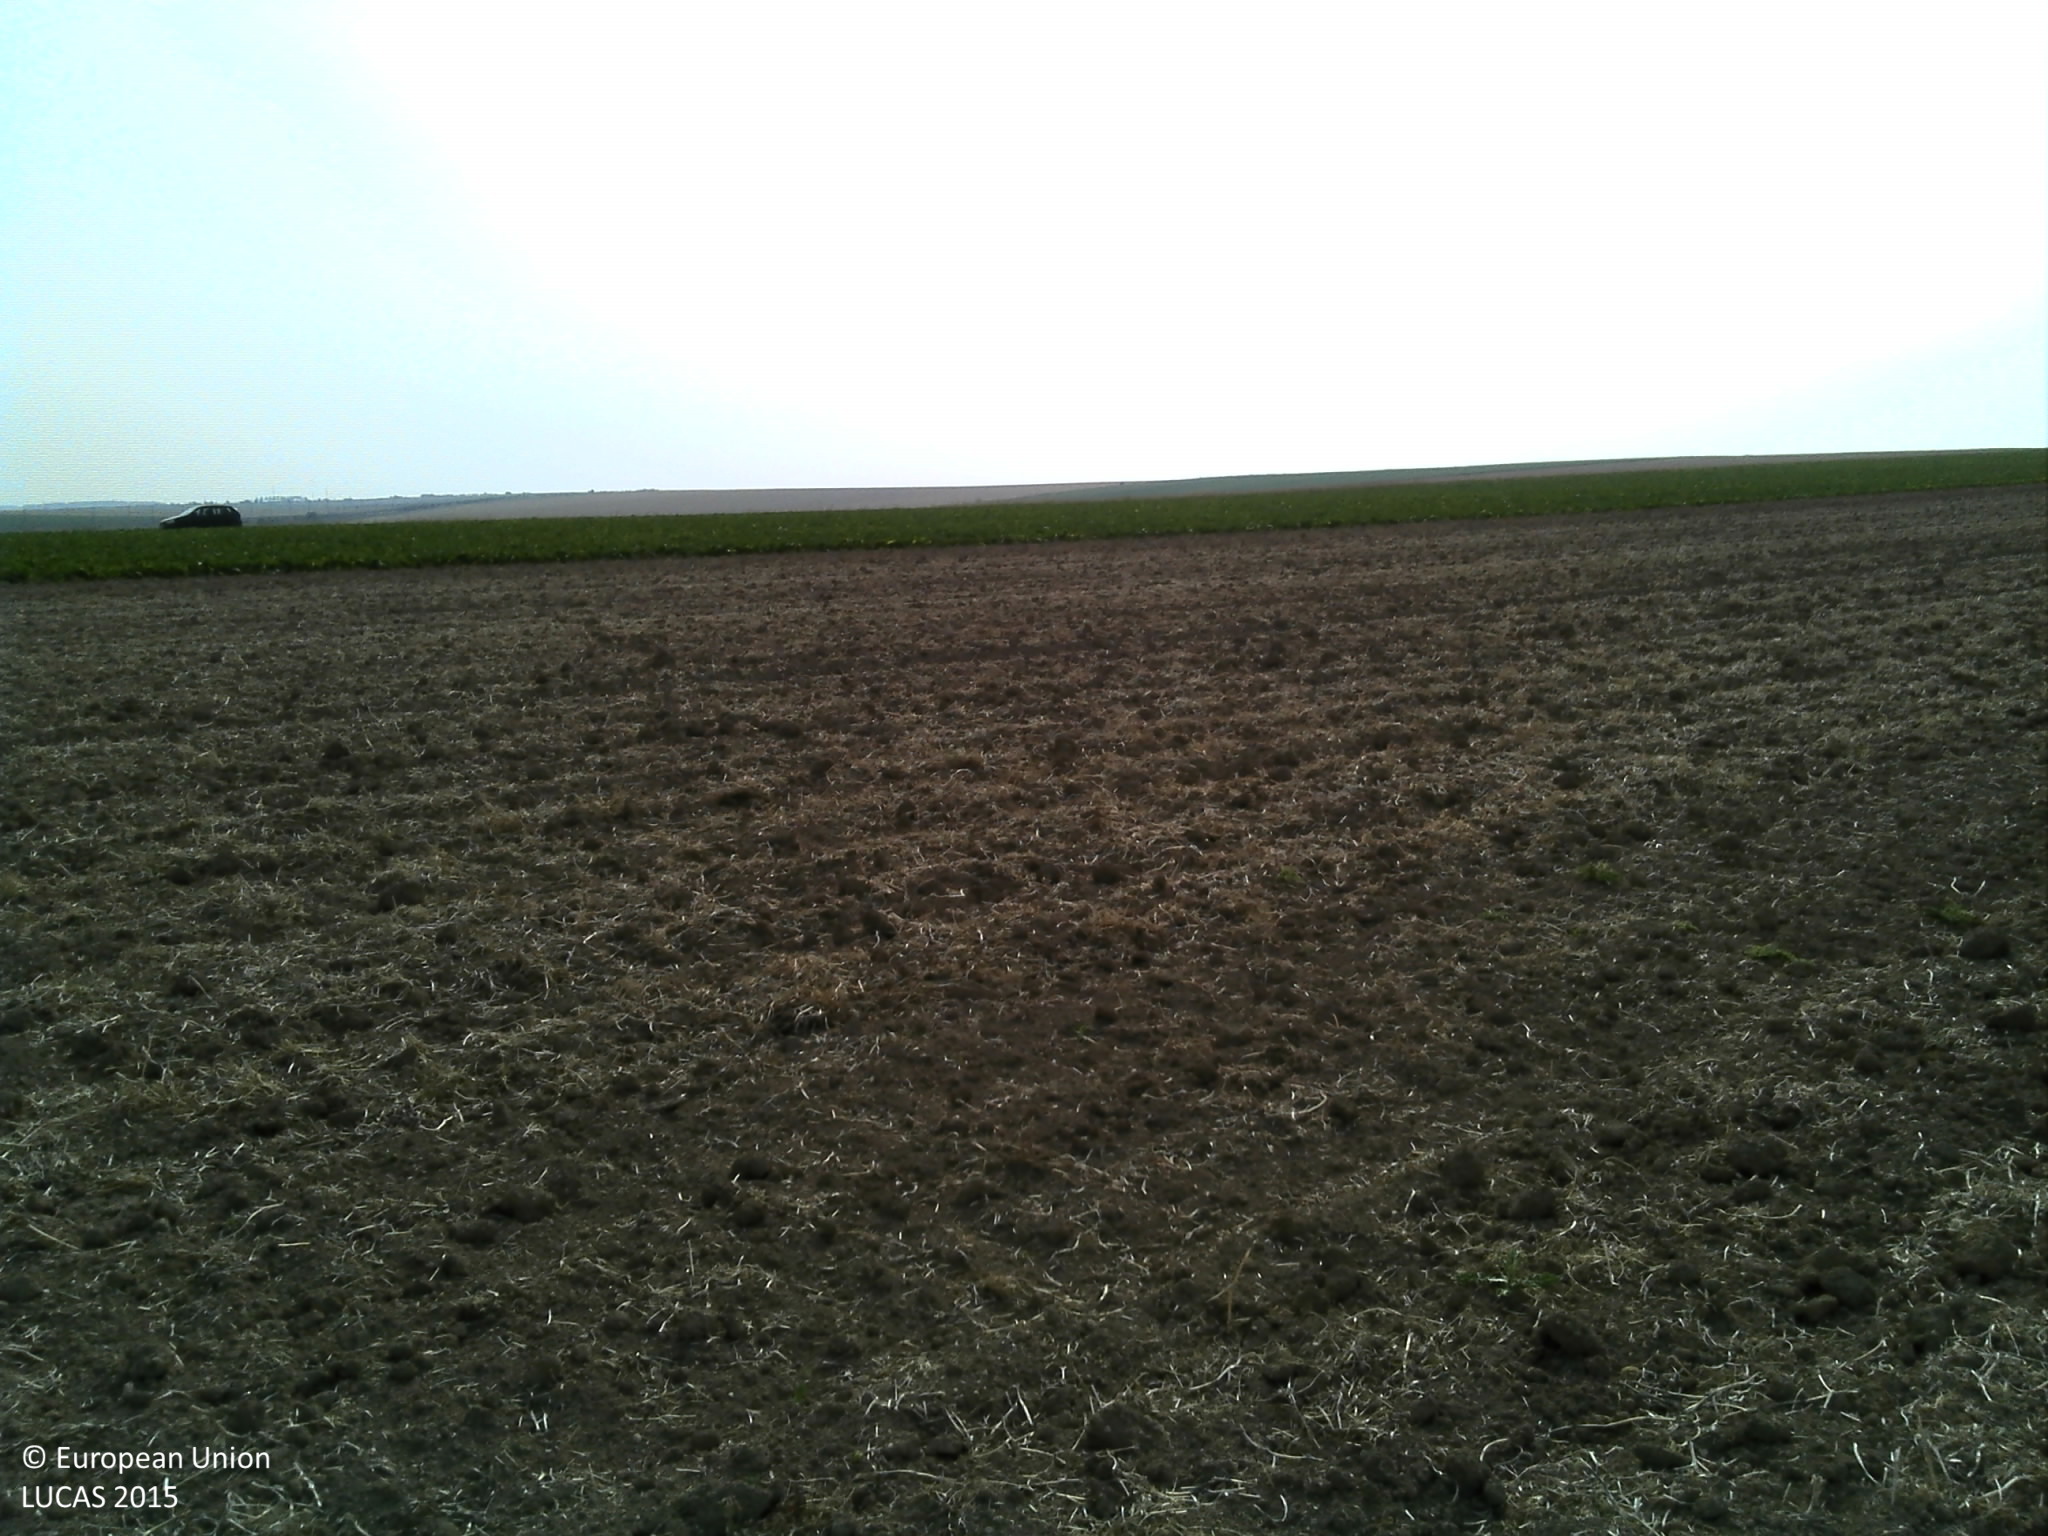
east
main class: Cropland
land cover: Dry pulses
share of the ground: 50 - 75 %
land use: Agriculture (excluding fallow land and kitchen gardens)
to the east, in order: Dry pulses; Sugar beet; Grass margins; Tracks; Grass margins; Common wheat
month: August
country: FR
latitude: 49.0273
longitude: 4.5673
